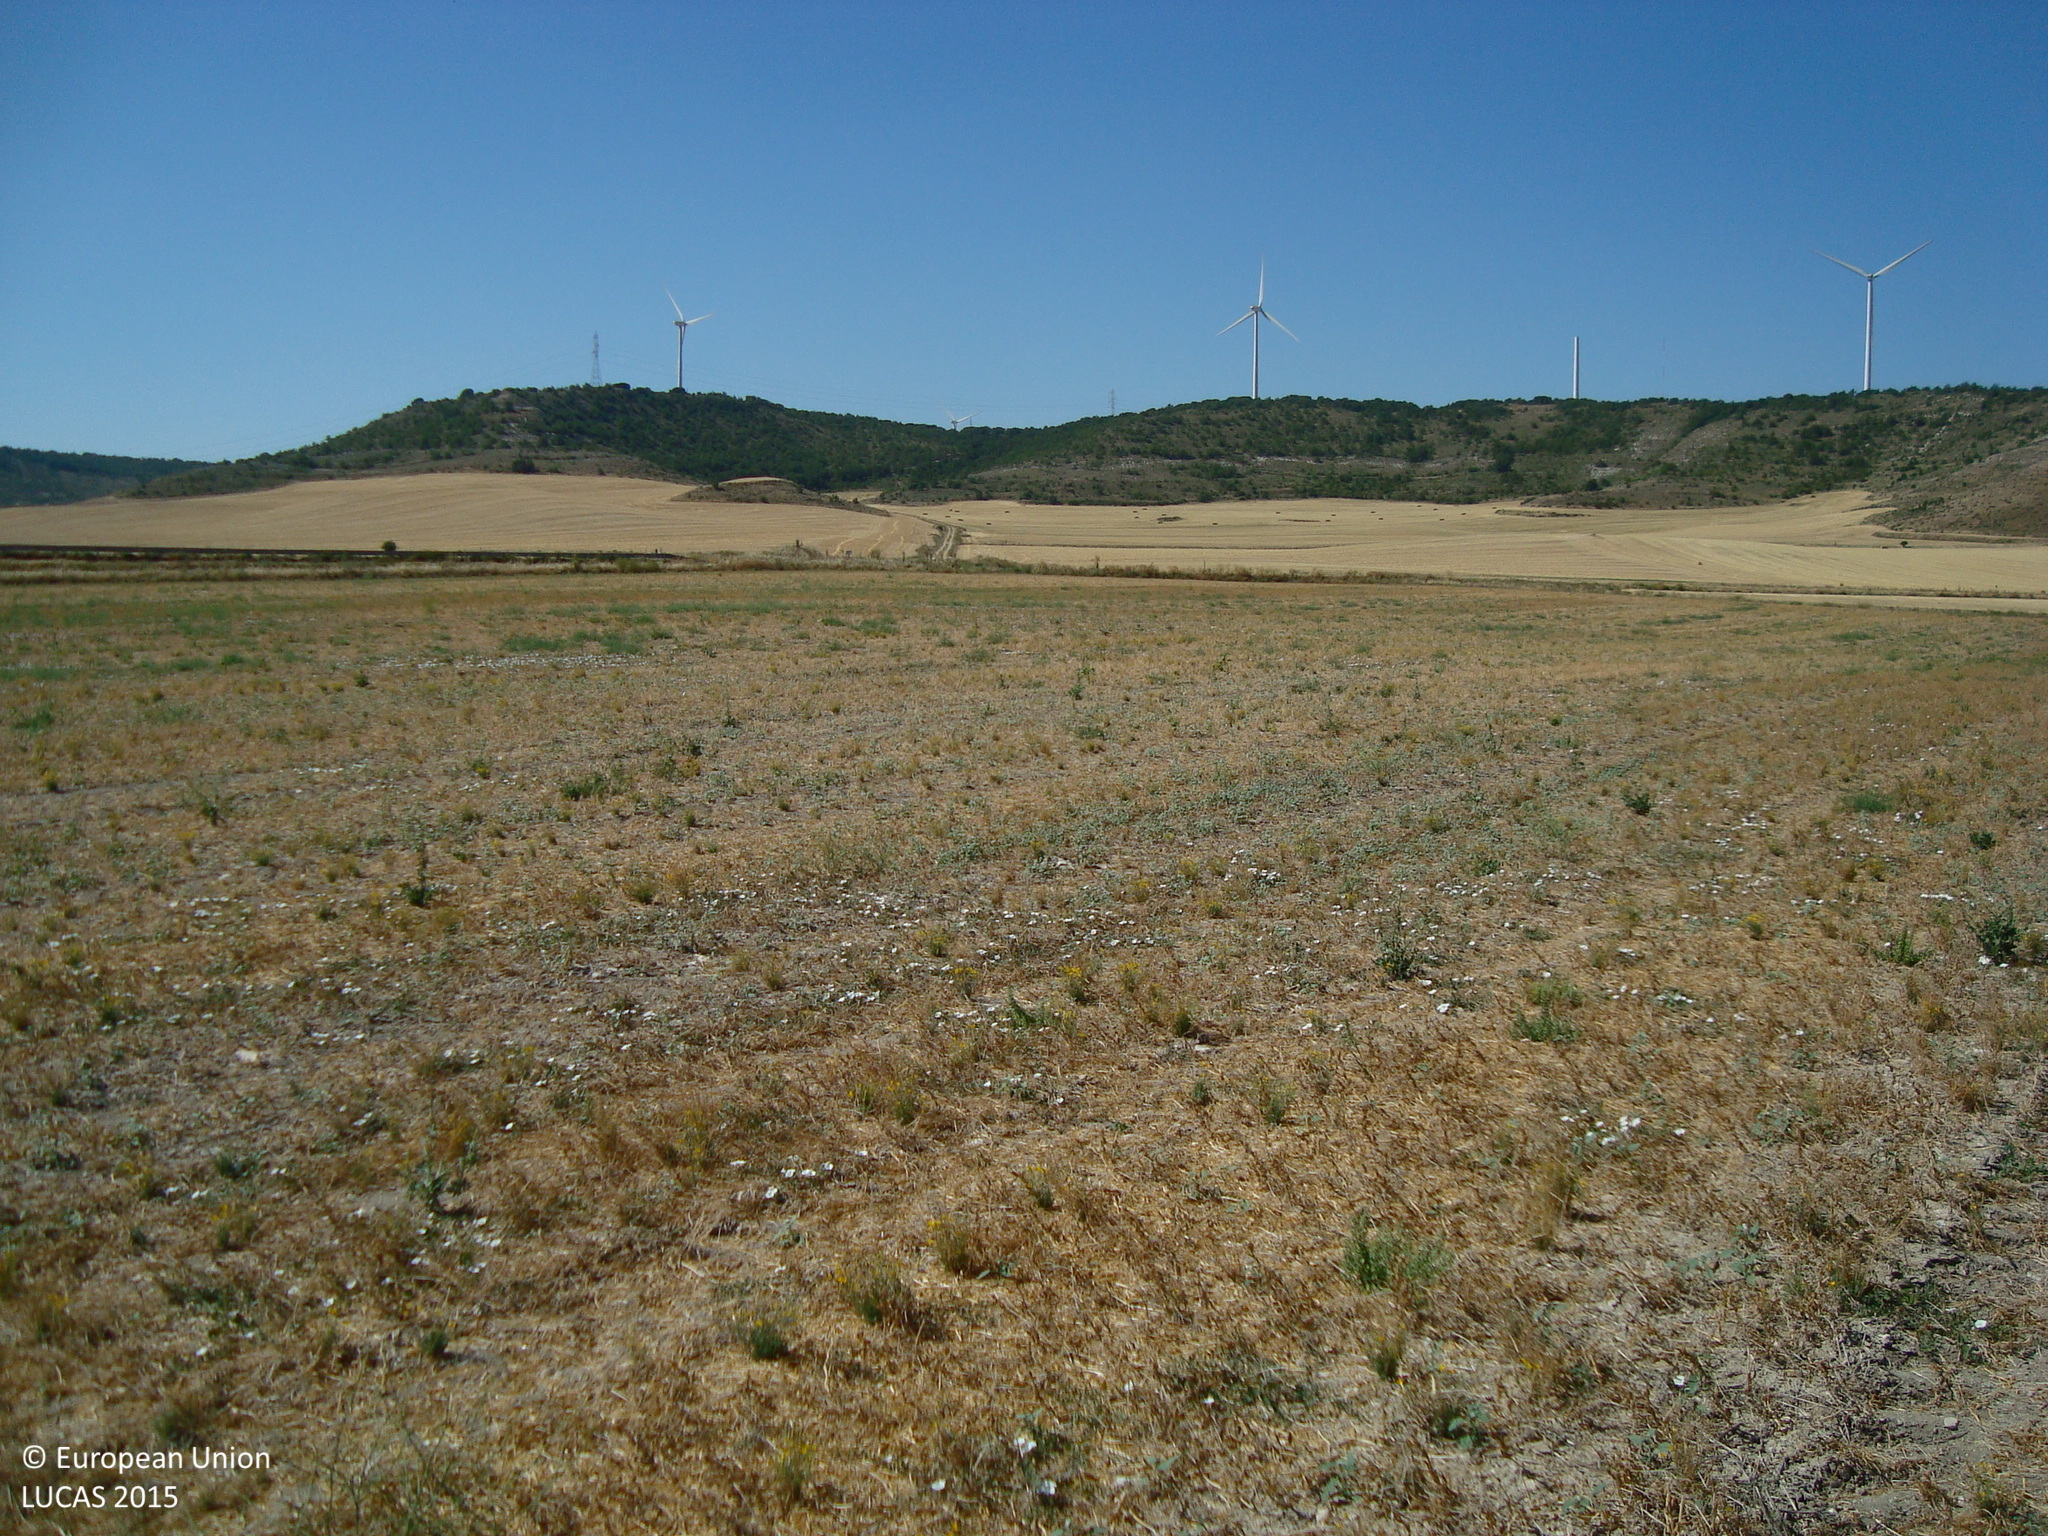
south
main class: Cropland
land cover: Dry pulses
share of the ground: 50 - 75 %
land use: Agriculture (excluding fallow land and kitchen gardens)
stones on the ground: 10 - 25 %
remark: Harvested field
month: July
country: ES
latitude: 42.0242
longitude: -4.2566
